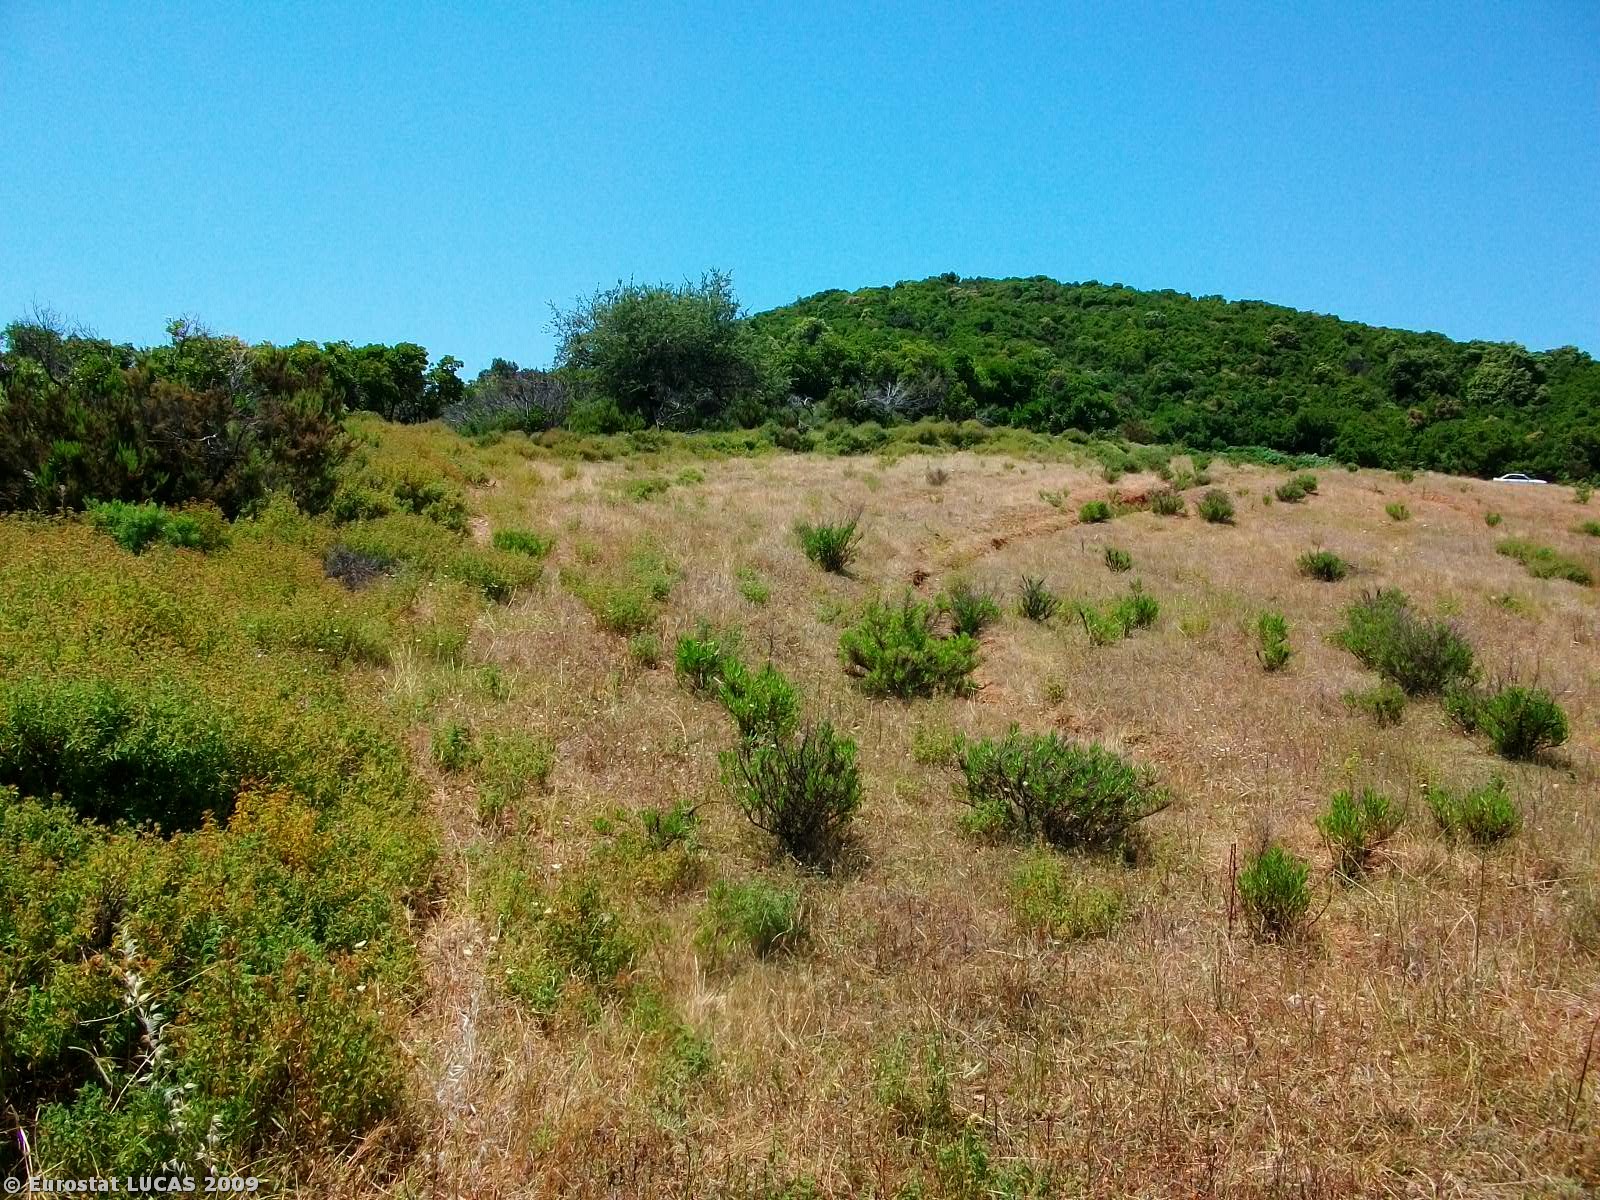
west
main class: Shrubland
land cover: Shrubland with sparse tree cover
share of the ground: > 75 %
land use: Agriculture (excluding fallow land and kitchen gardens)
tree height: > 5 m
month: June
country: GR
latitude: 39.1994
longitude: 23.2508
